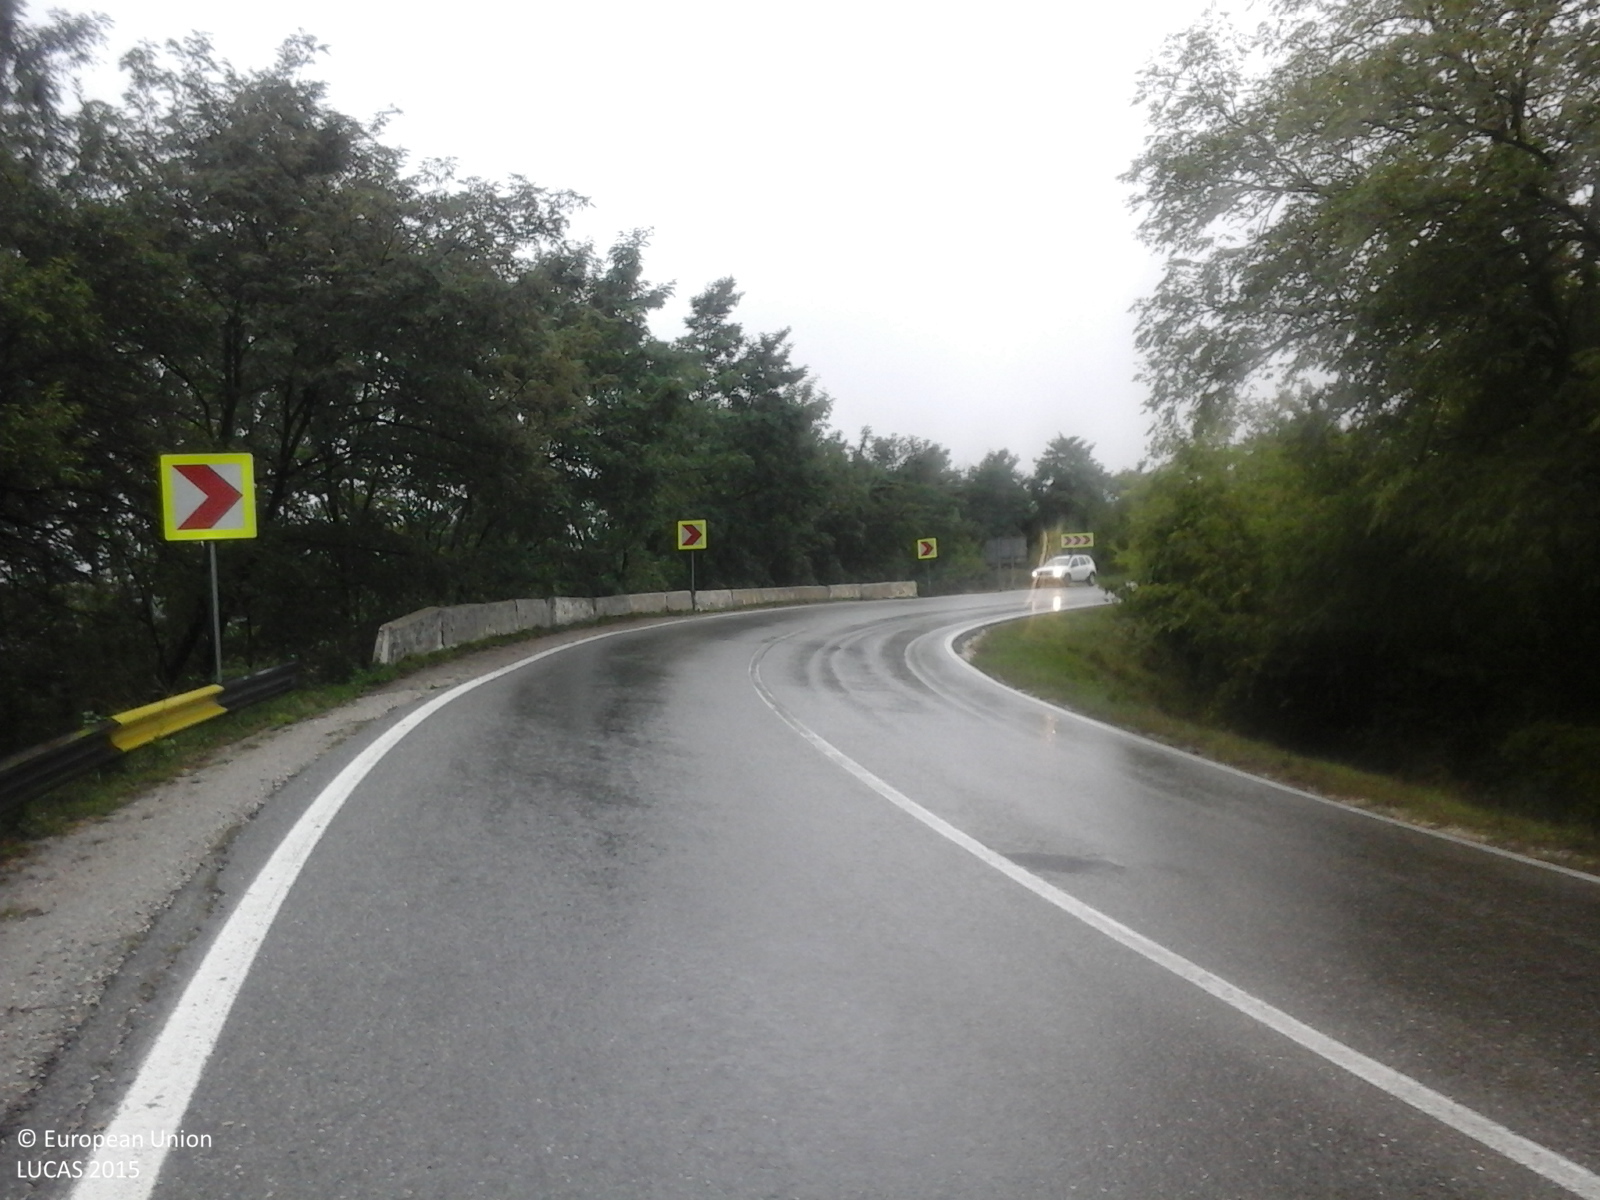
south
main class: Grassland
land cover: Grassland without tree/shrub cover
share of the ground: > 75 %
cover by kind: herbaceous plants 100 %
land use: Agriculture (excluding fallow land and kitchen gardens)
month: September
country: RO
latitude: 45.1430
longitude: 23.7855
